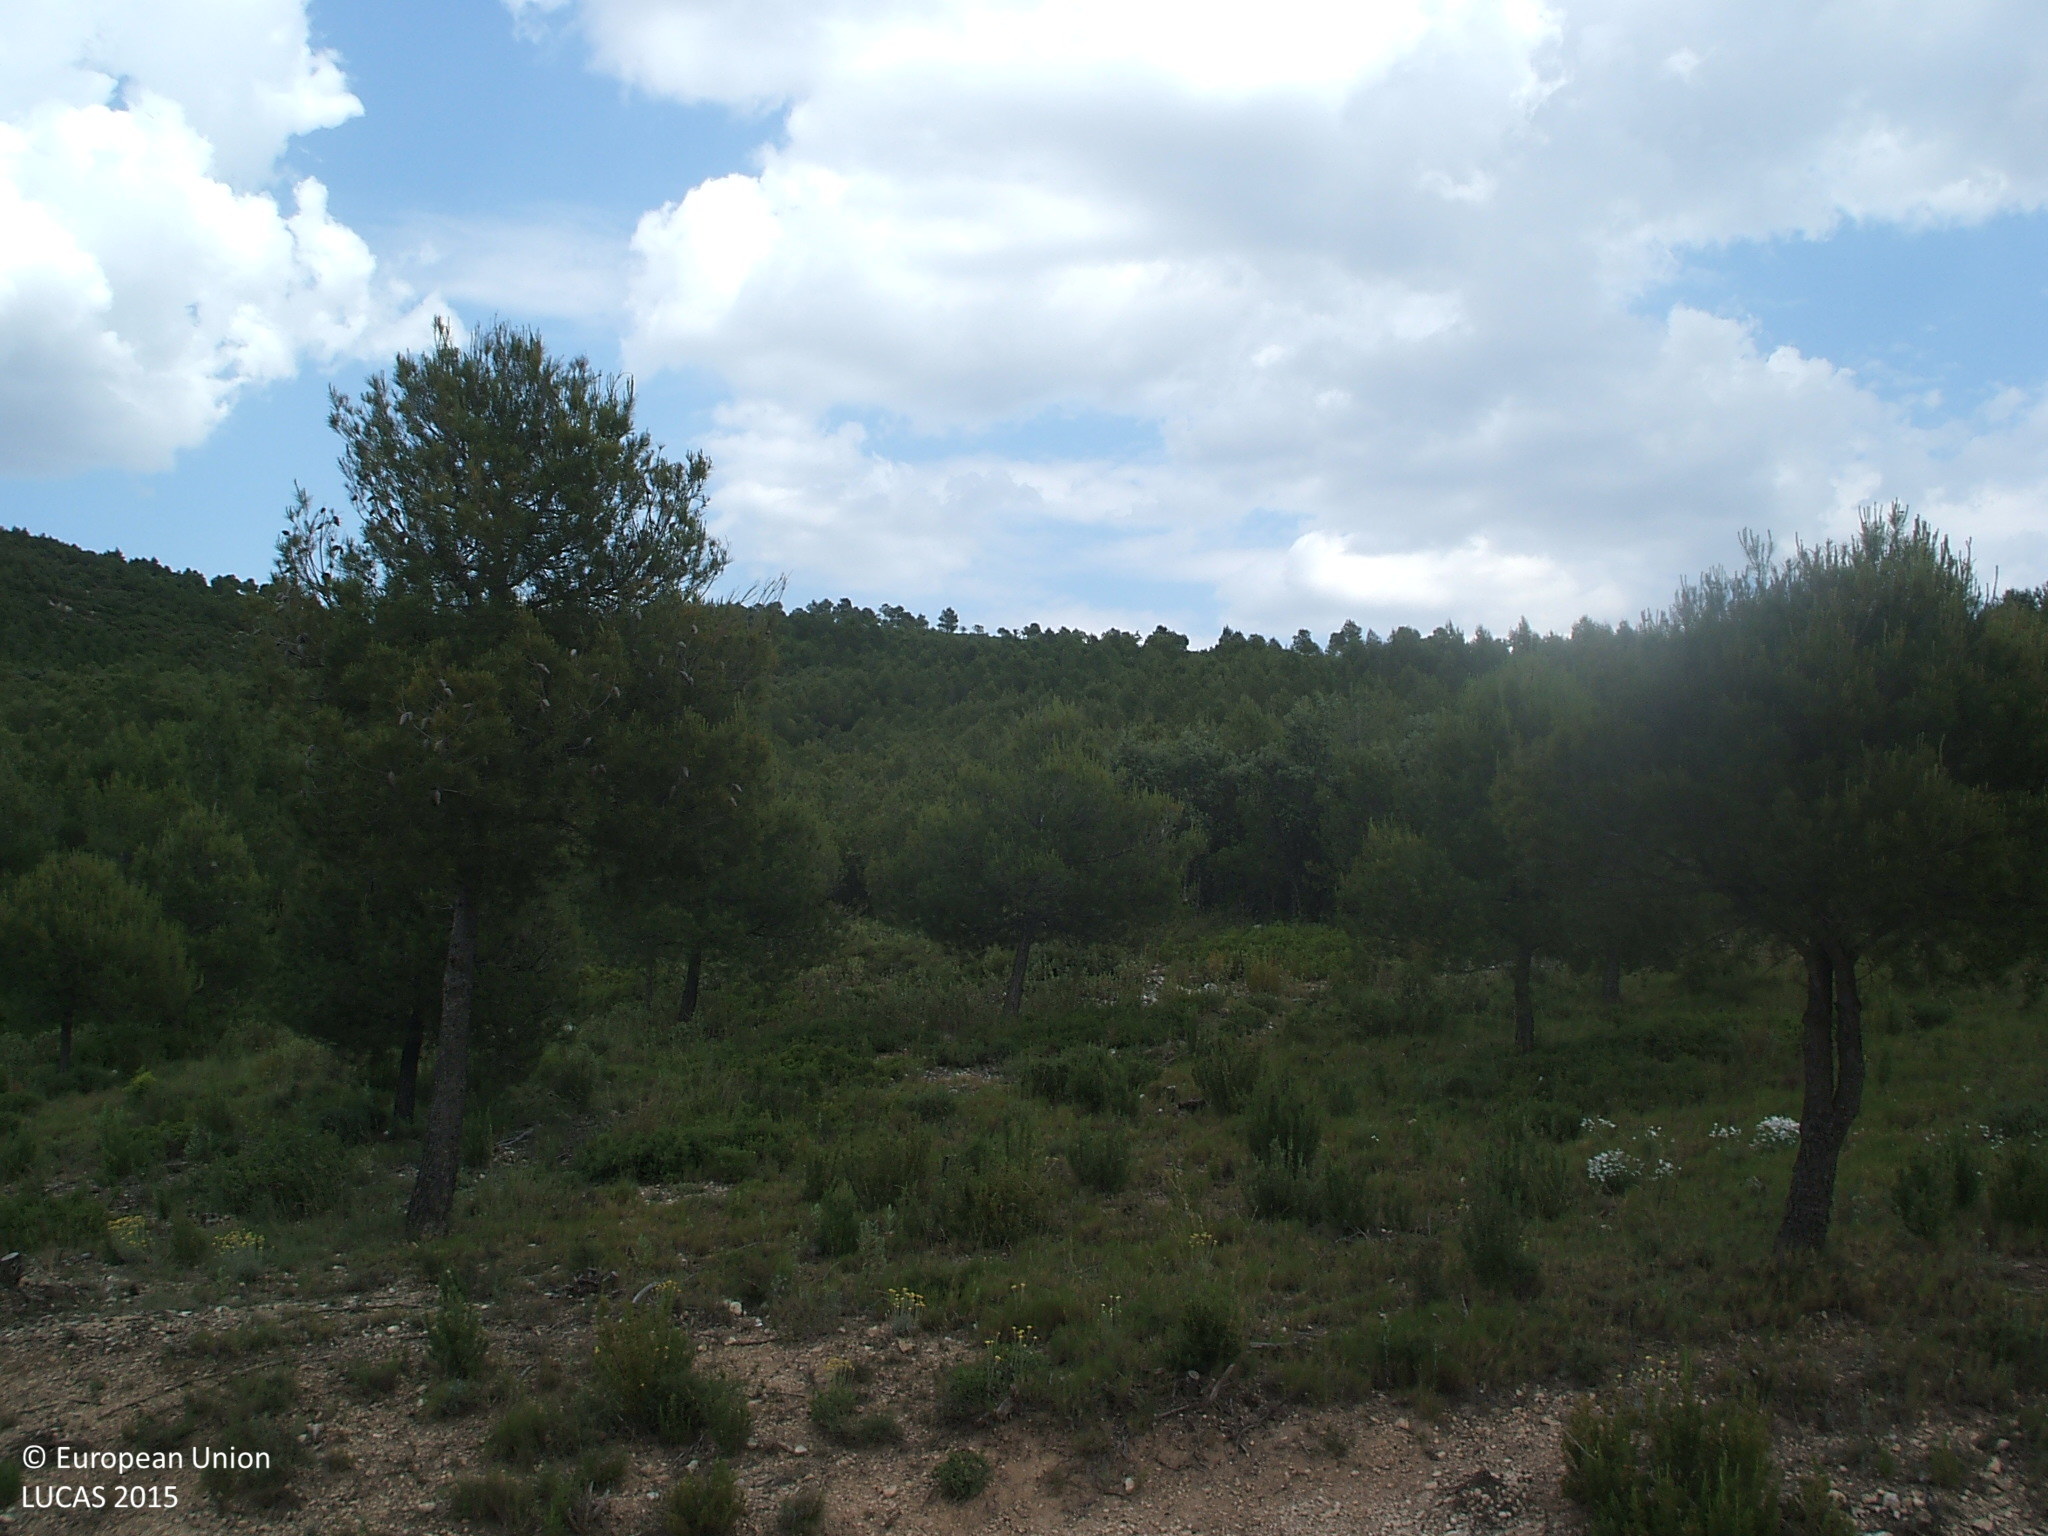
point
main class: Woodland
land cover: Pine dominated coniferous woodland
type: coniferous forest of the mediterranean region
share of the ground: > 75 %
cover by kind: coniferous forest trees 100 %
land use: Semi-natural and natural areas not in use
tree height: > 5 m
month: June
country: ES
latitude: 40.8865
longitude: -0.1573
